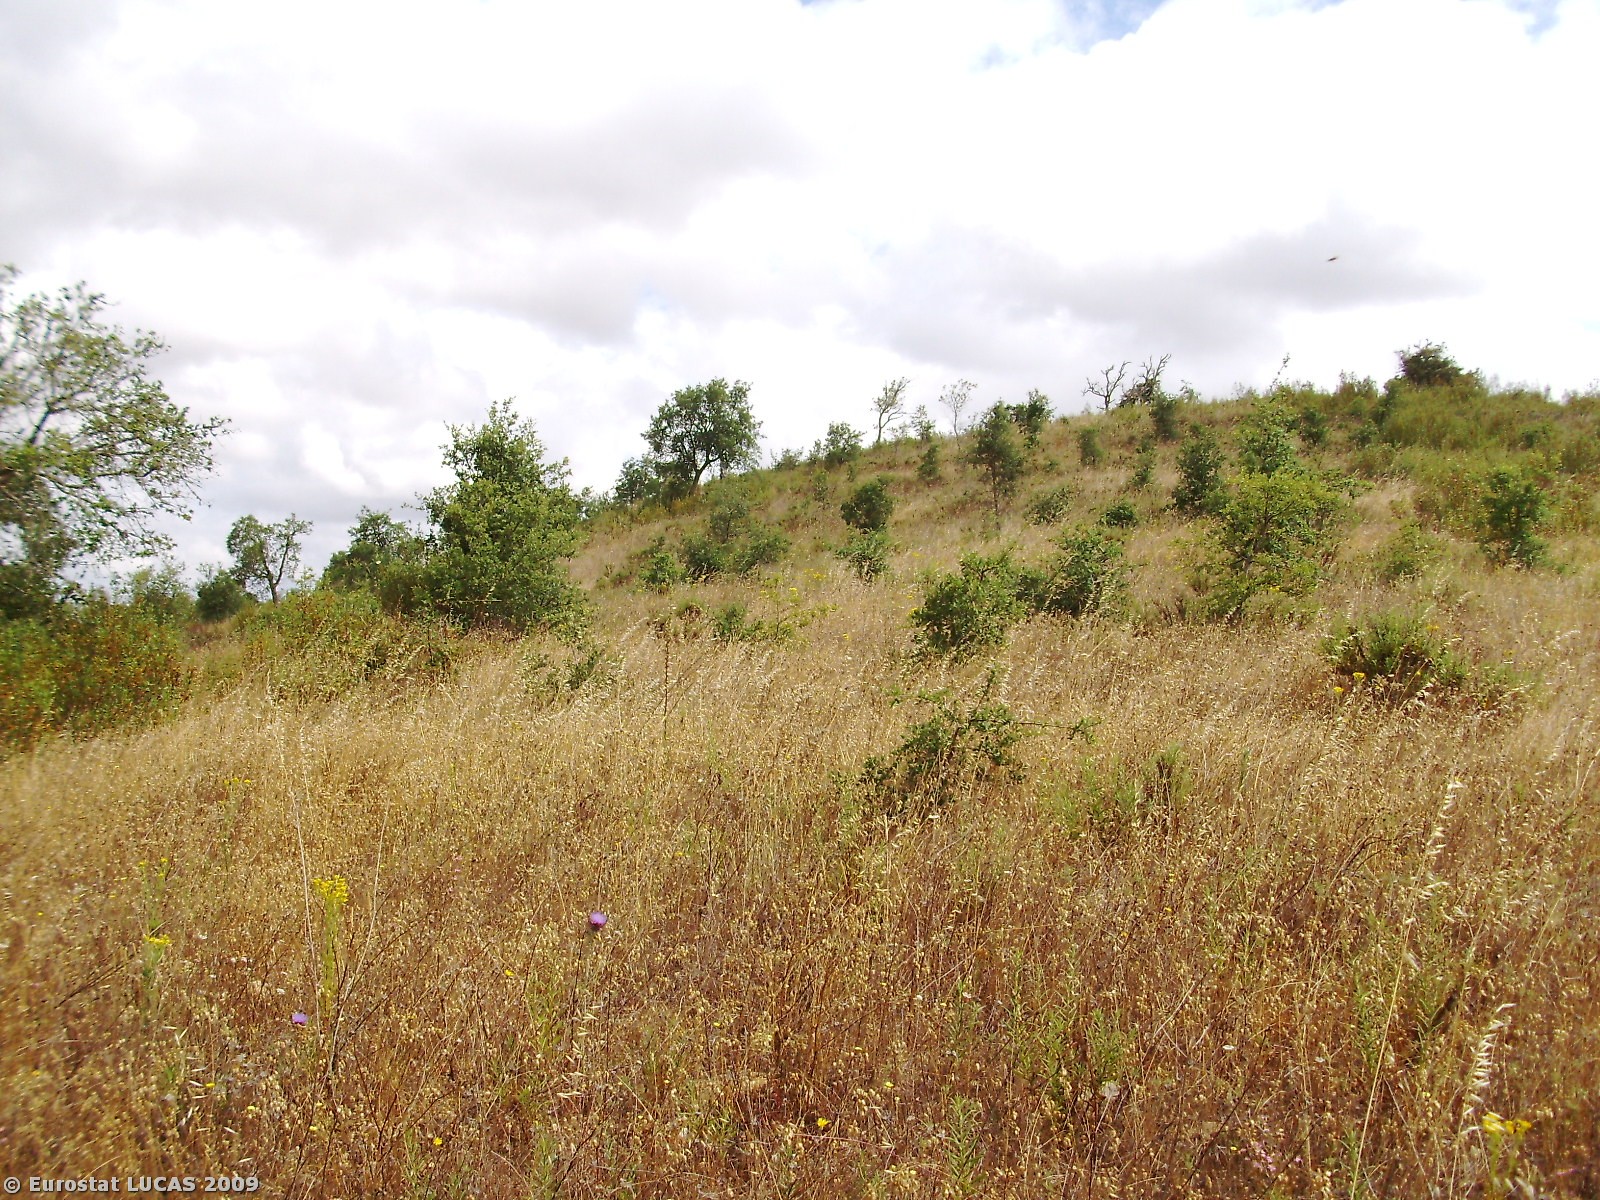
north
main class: Woodland
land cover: Broadleaved woodland
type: broadleaved evergreen forest
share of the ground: 10 - 25 %
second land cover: Shrubland with sparse tree cover
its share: 25 - 50 %
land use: Forestry
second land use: Fallow land
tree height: > 5 m
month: June
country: PT
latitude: 37.8327
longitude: -8.6431
